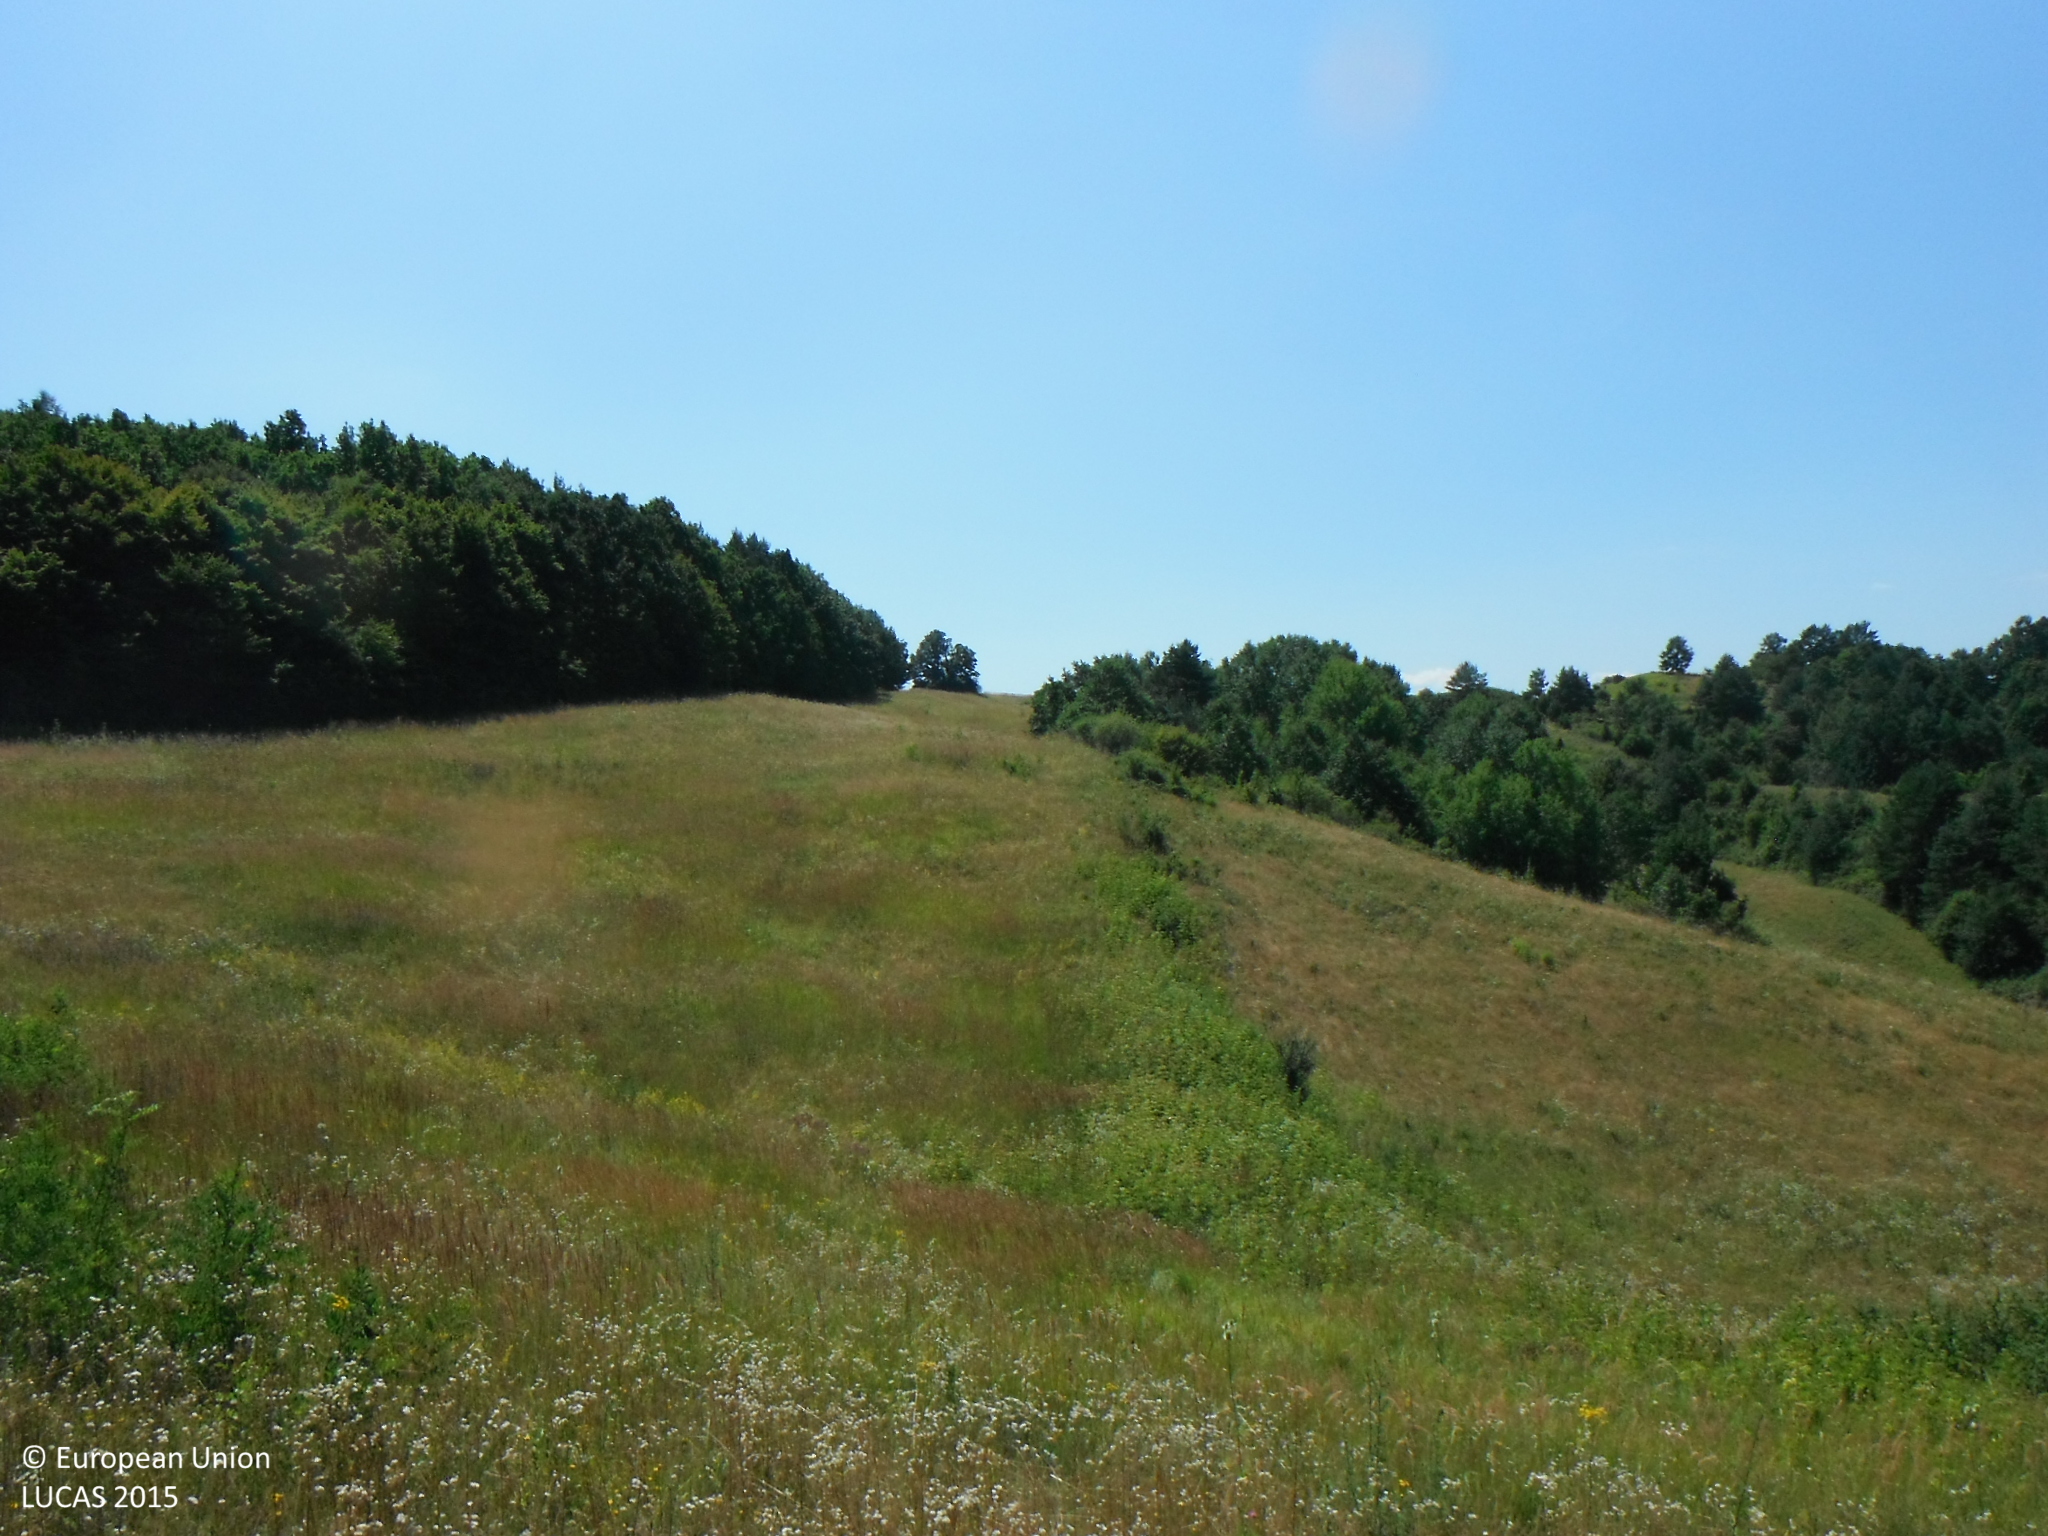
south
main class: Grassland
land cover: Spontaneously vegetated surfaces
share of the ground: > 75 %
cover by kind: herbaceous plants 100 %
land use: Fallow land
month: July
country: SK
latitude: 48.2134
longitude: 20.0827
